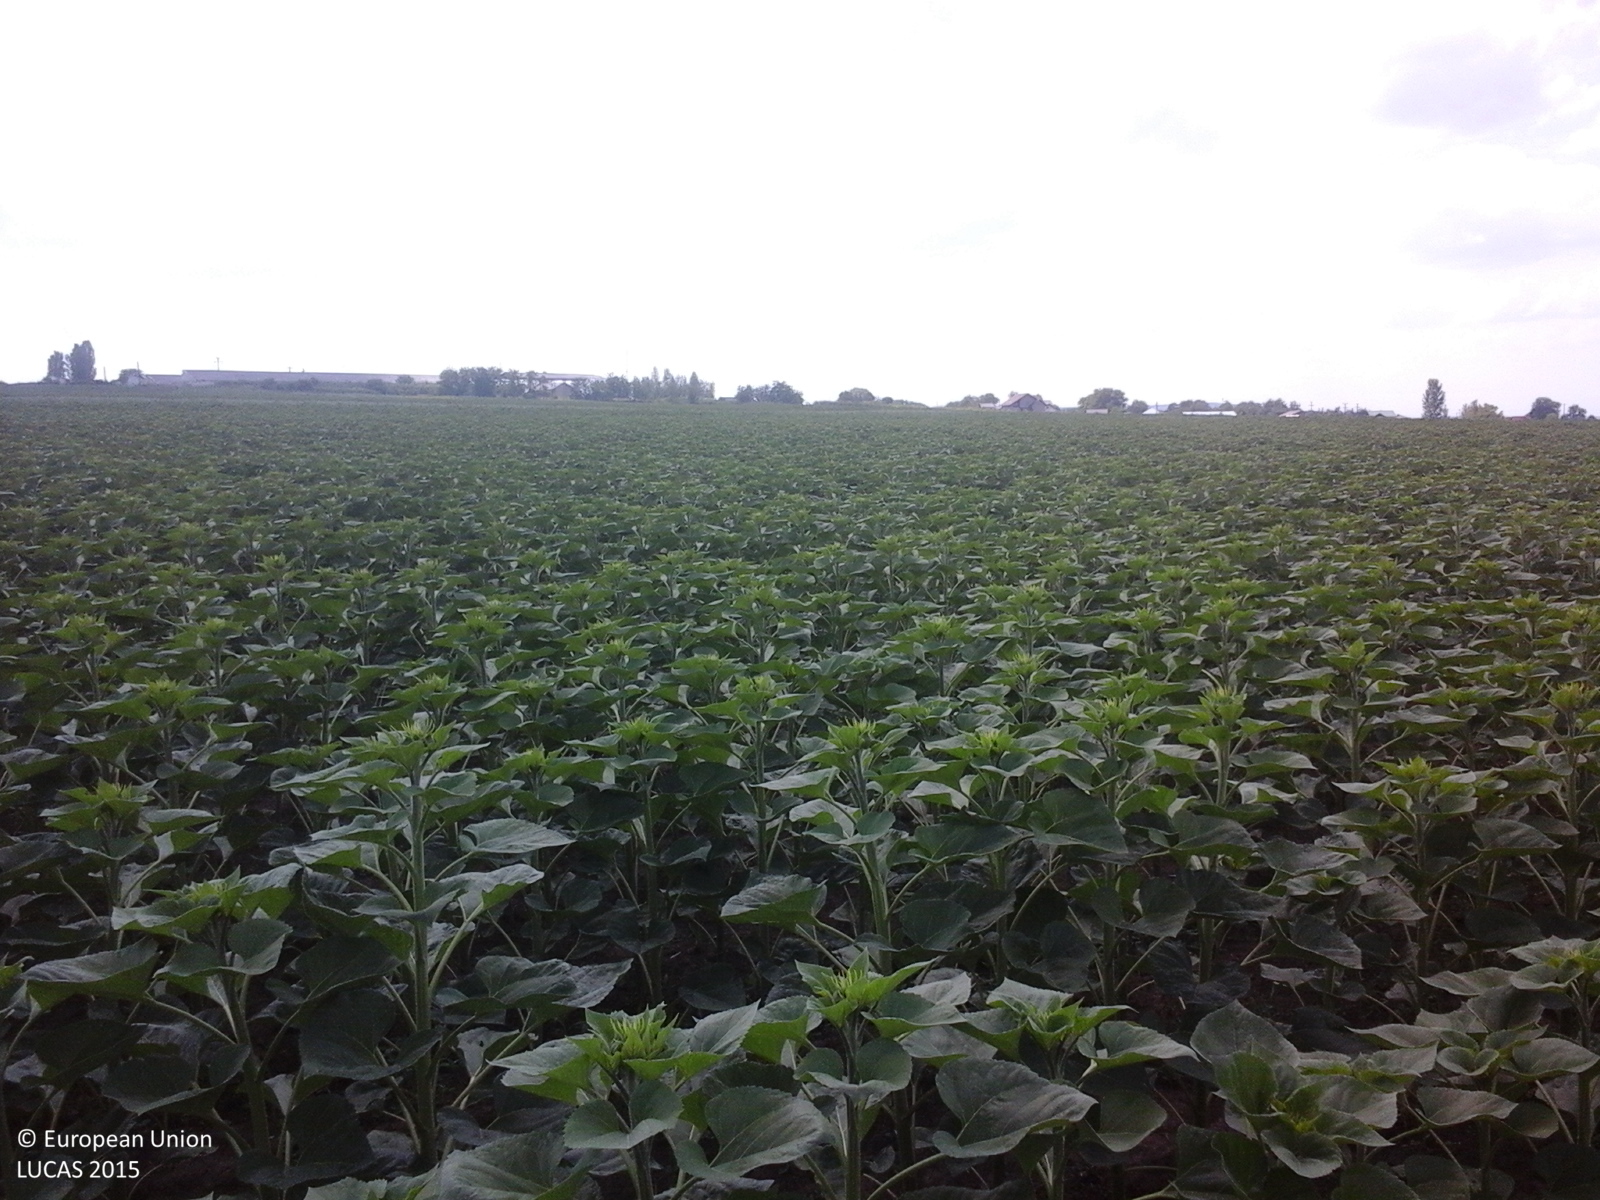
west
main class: Cropland
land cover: Sunflower
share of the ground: > 75 %
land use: Agriculture (excluding fallow land and kitchen gardens)
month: June
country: RO
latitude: 47.8988
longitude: 26.4220
